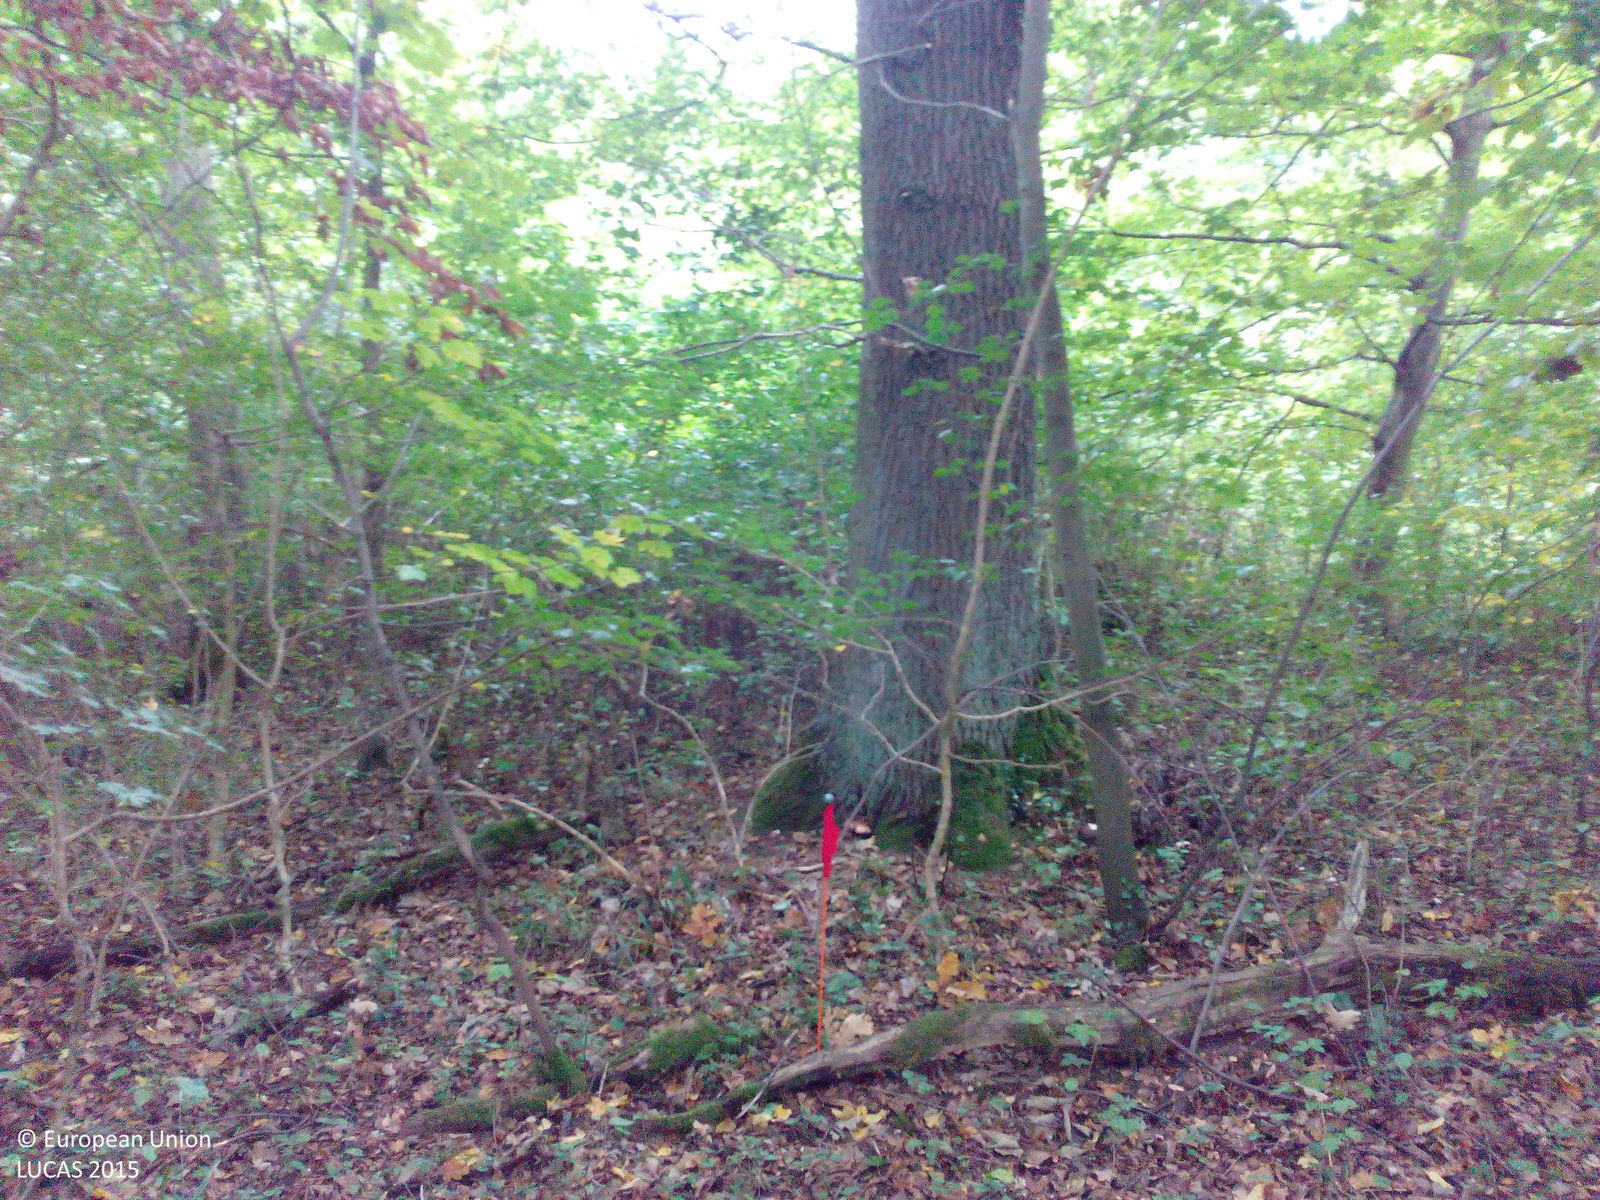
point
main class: Woodland
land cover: Broadleaved woodland
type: mesophytic deciduous forest
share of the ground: > 75 %
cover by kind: broadleaved forest trees 100 %
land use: Forestry
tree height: > 5 m
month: September
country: DE
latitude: 51.5505
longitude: 9.8414
